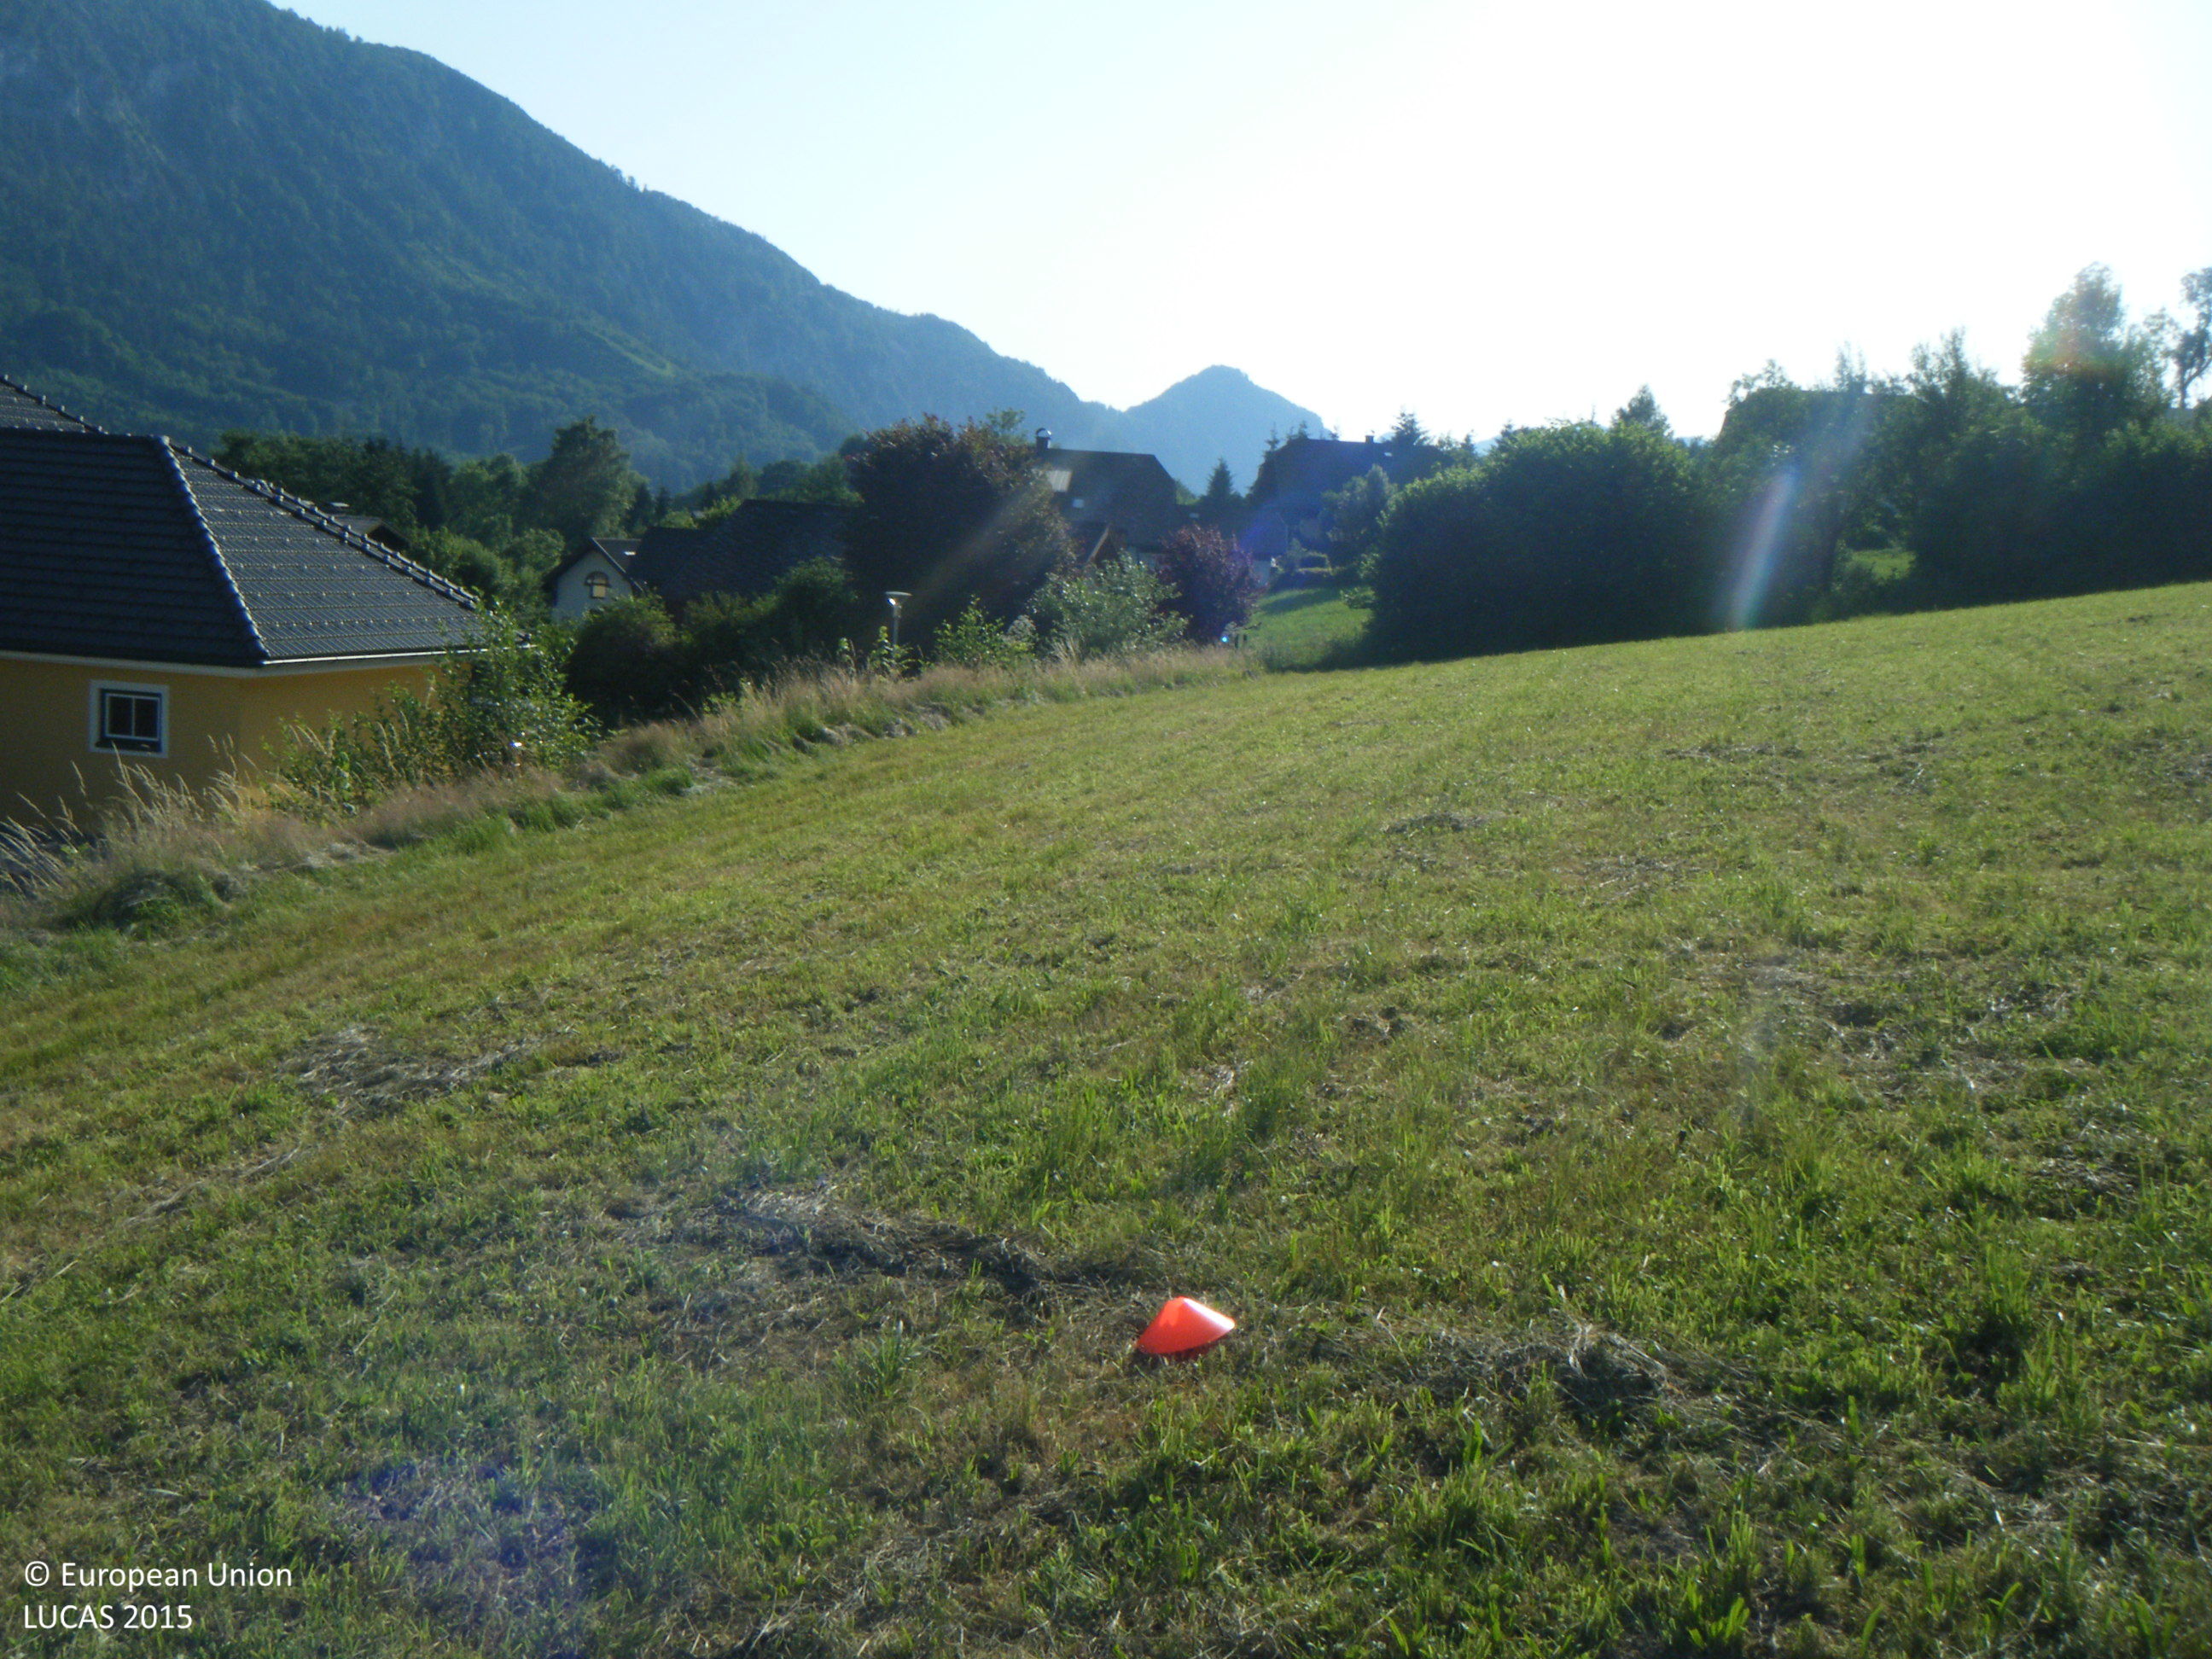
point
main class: Grassland
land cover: Grassland without tree/shrub cover
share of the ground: > 75 %
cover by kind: herbaceous plants 100 %
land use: Agriculture (excluding fallow land and kitchen gardens)
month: July
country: AT
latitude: 47.8083
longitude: 13.4840
